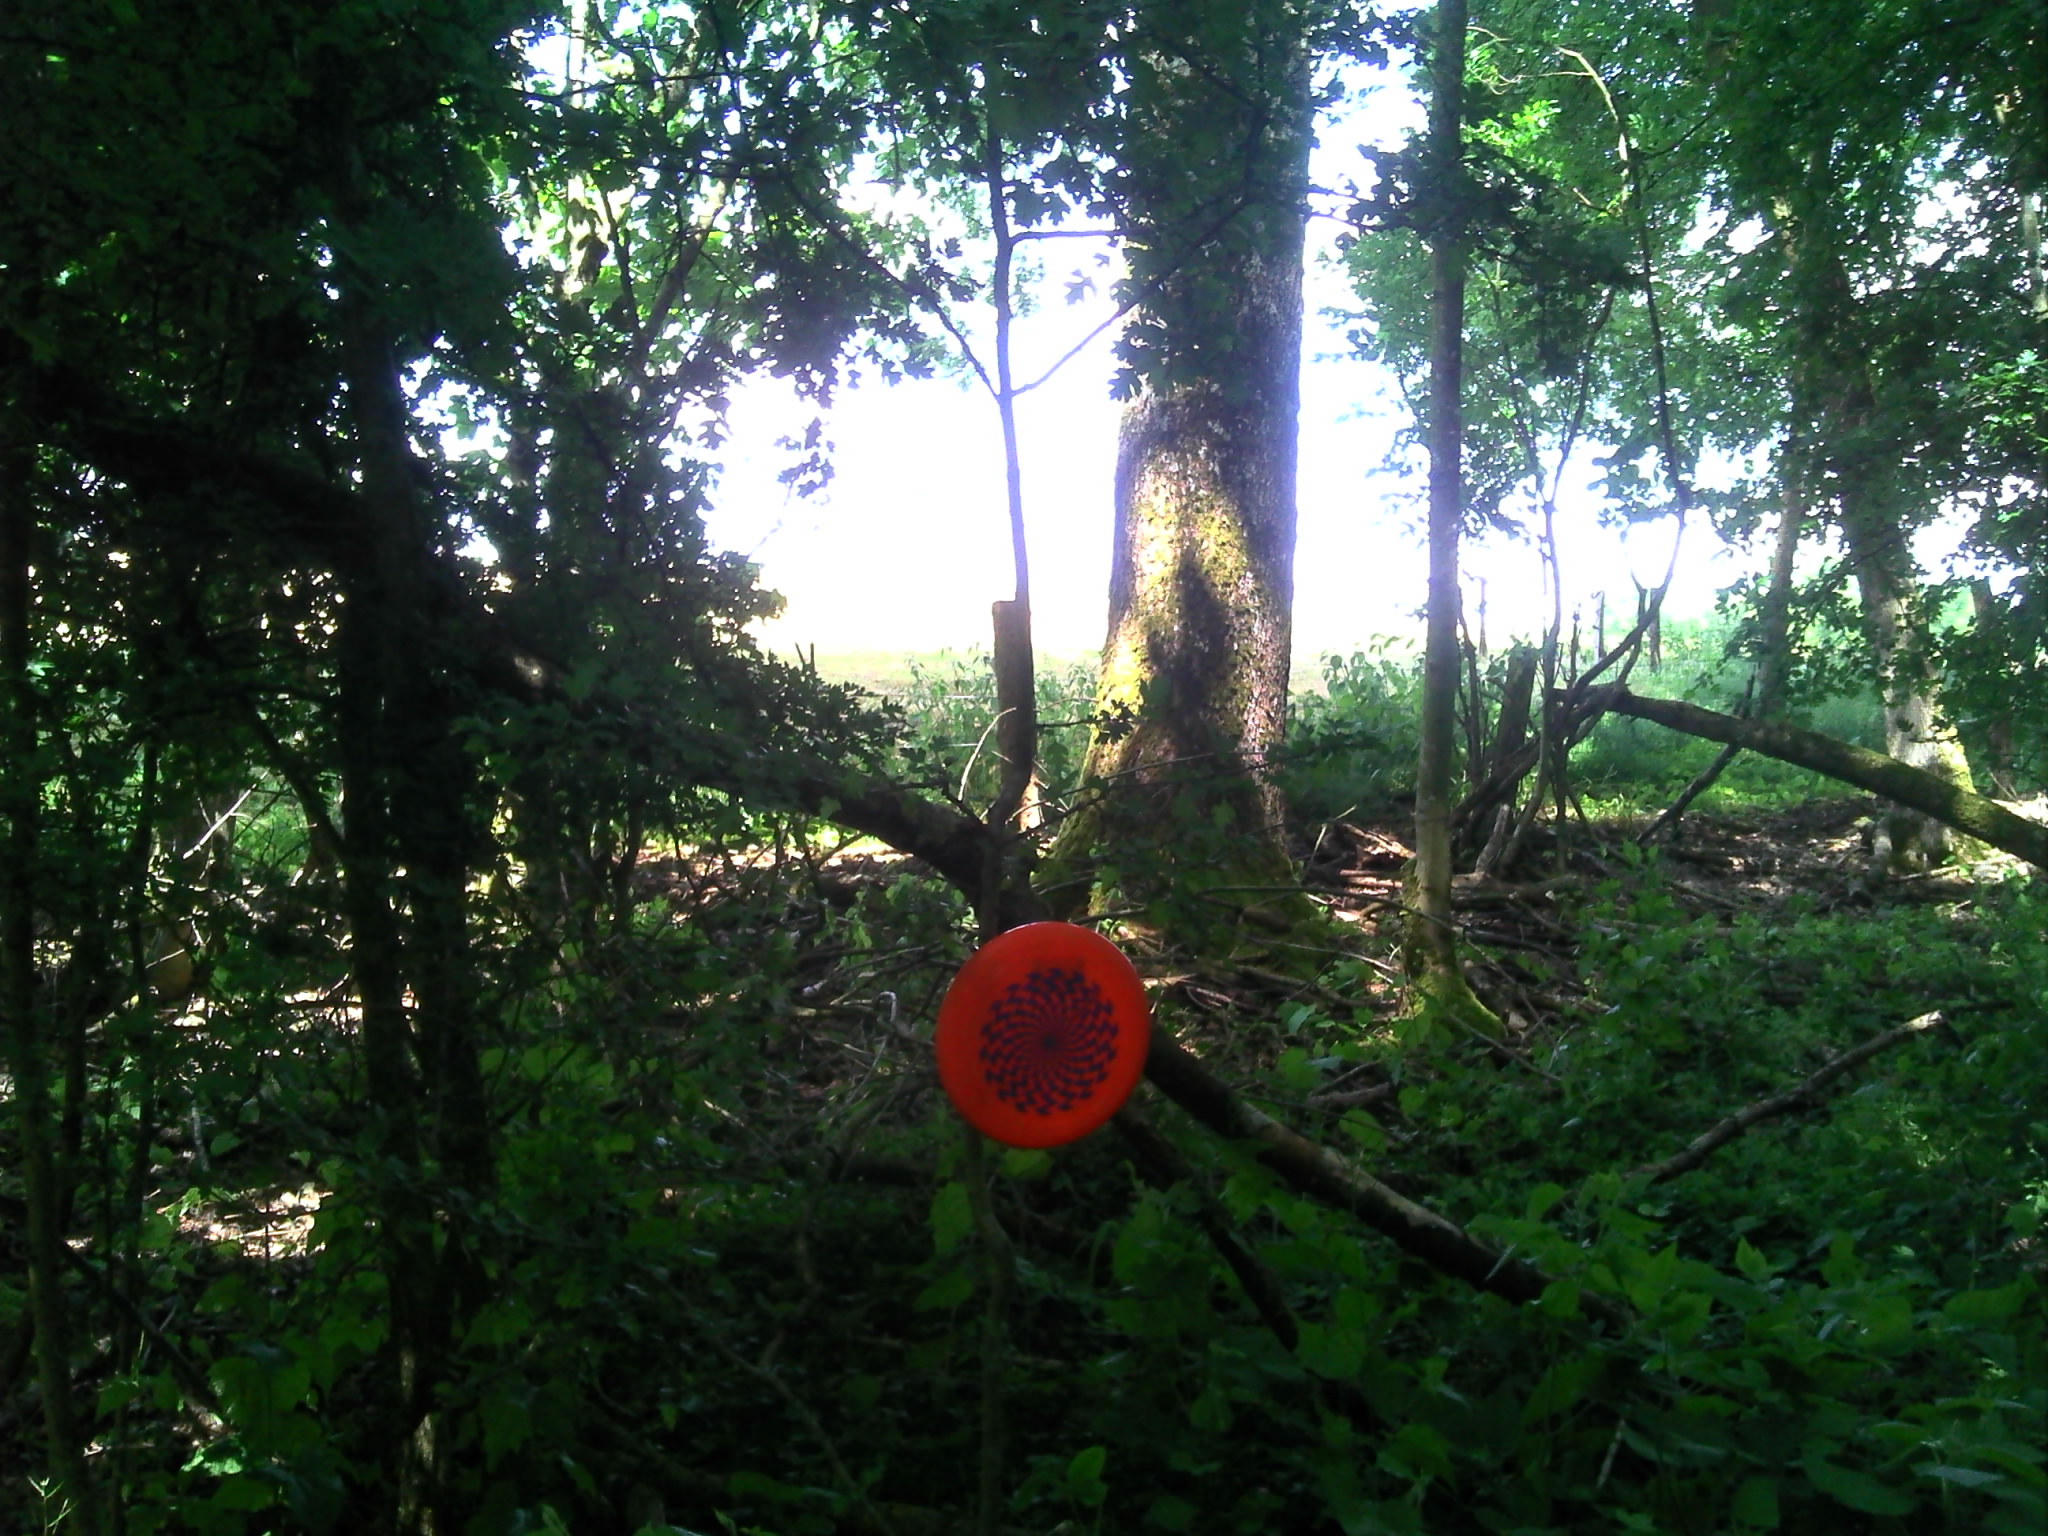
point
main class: Woodland
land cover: Broadleaved woodland
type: mesophytic deciduous forest
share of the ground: > 75 %
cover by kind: broadleaved forest trees 100 %
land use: Forestry
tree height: > 5 m
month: June
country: BE
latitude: 50.2257
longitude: 5.1617
